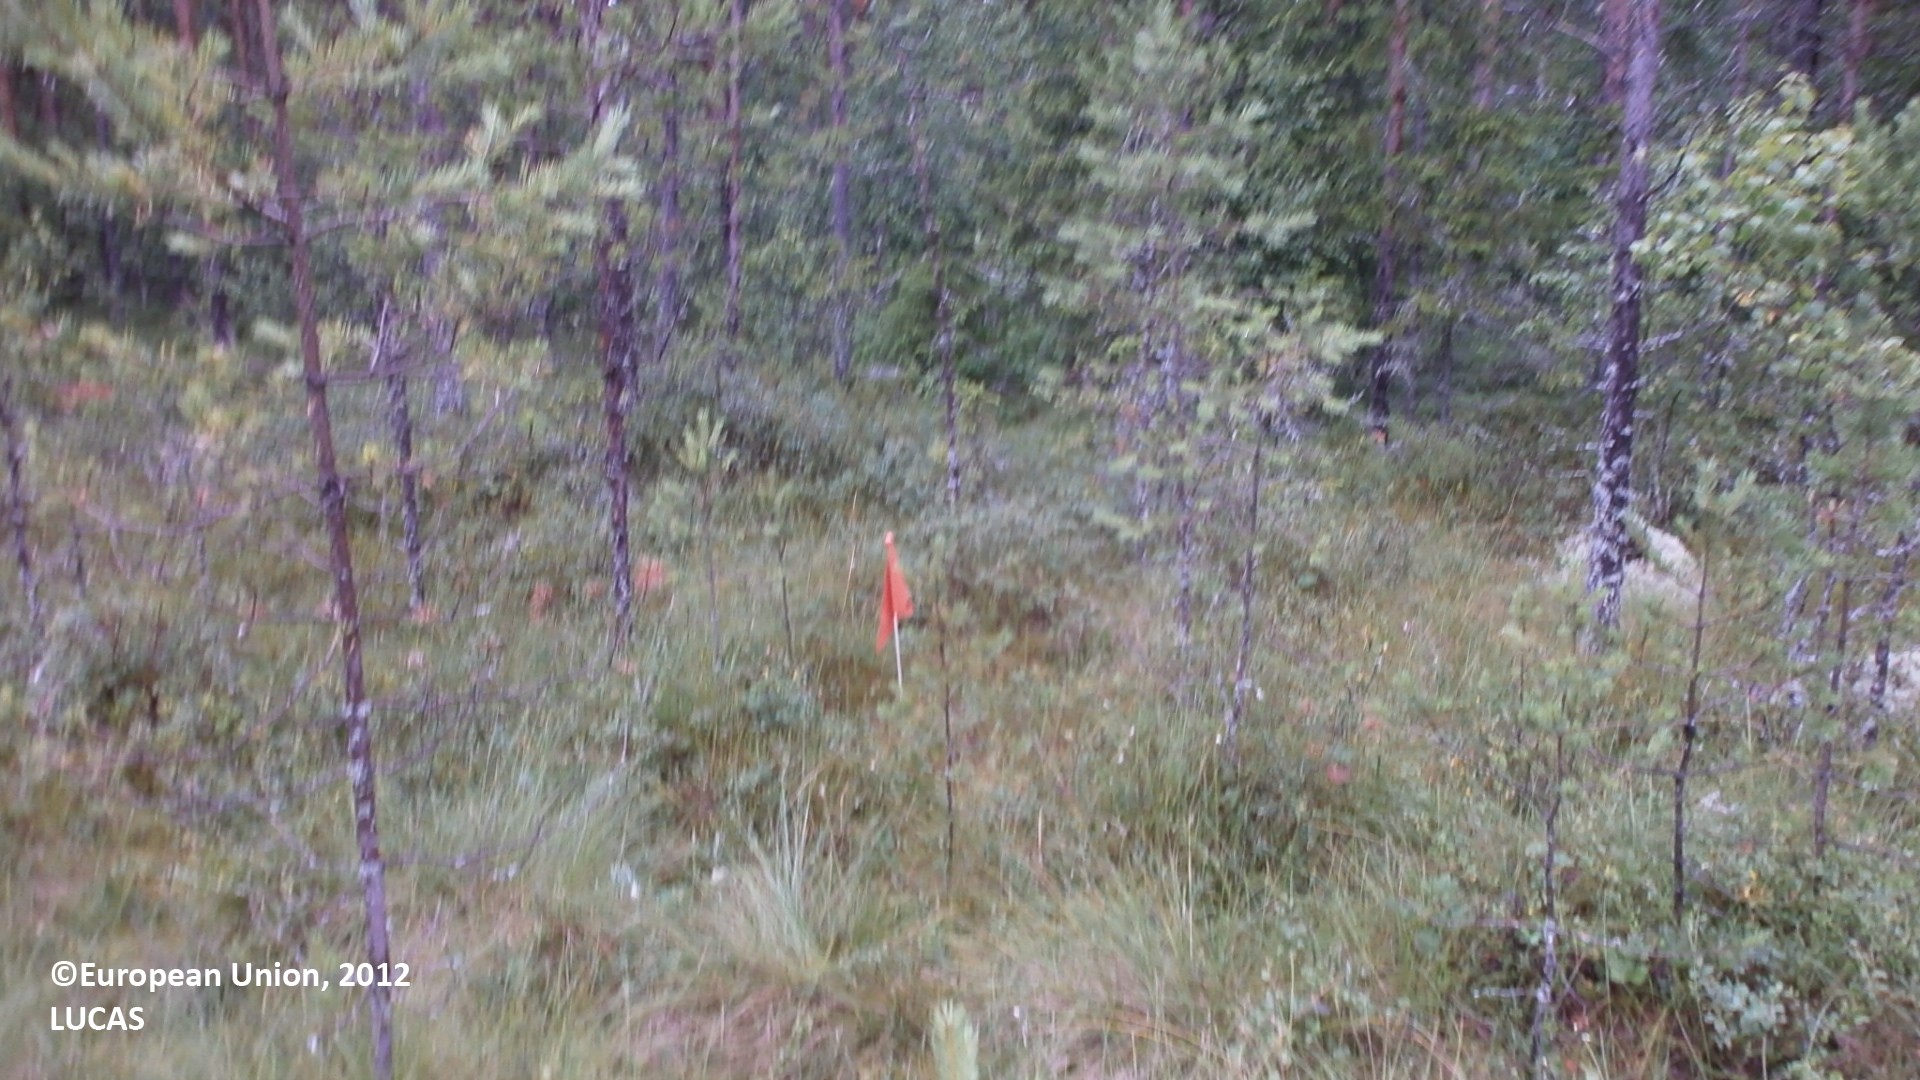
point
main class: Woodland
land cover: Pine dominated coniferous woodland
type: mire and swamp forests
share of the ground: 50 - 75 %
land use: Forestry
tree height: > 5 m
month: July
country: FI
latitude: 64.0733
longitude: 23.7333
